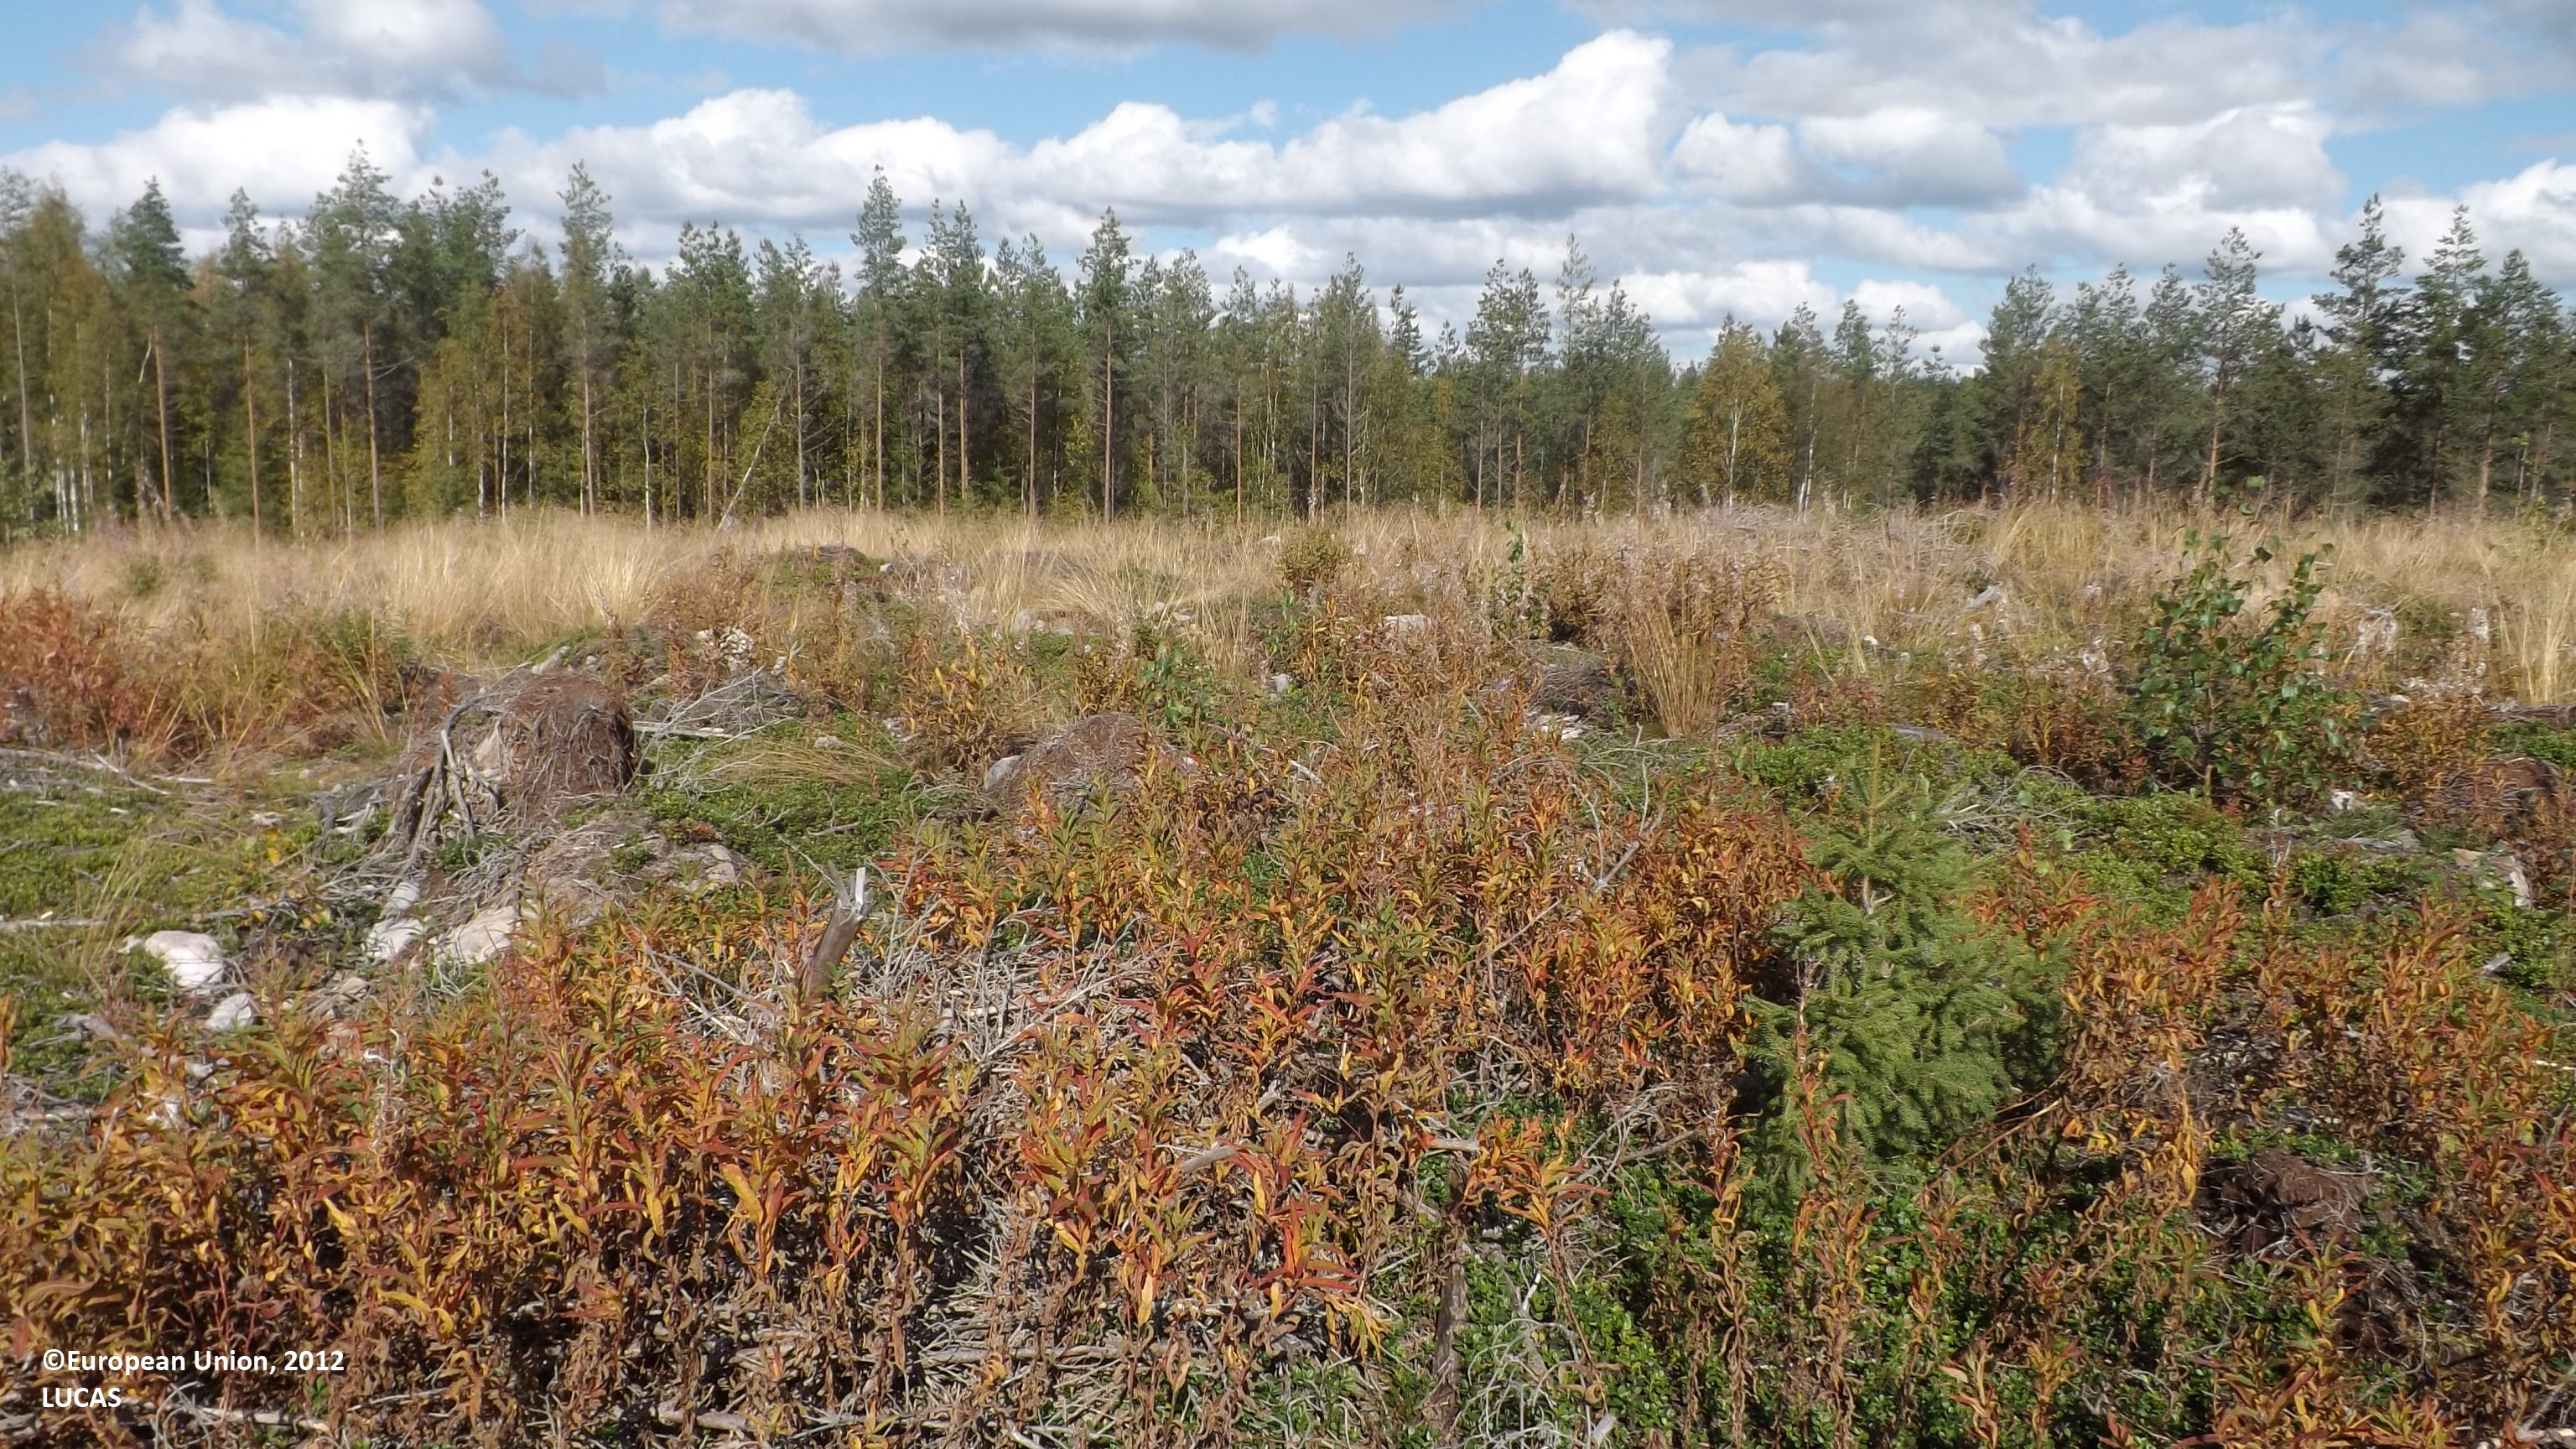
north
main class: Shrubland
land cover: Shrubland without tree cover
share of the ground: 25 - 50 %
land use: Forestry
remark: Clear cut
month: August
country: FI
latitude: 63.6466
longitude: 23.5696
